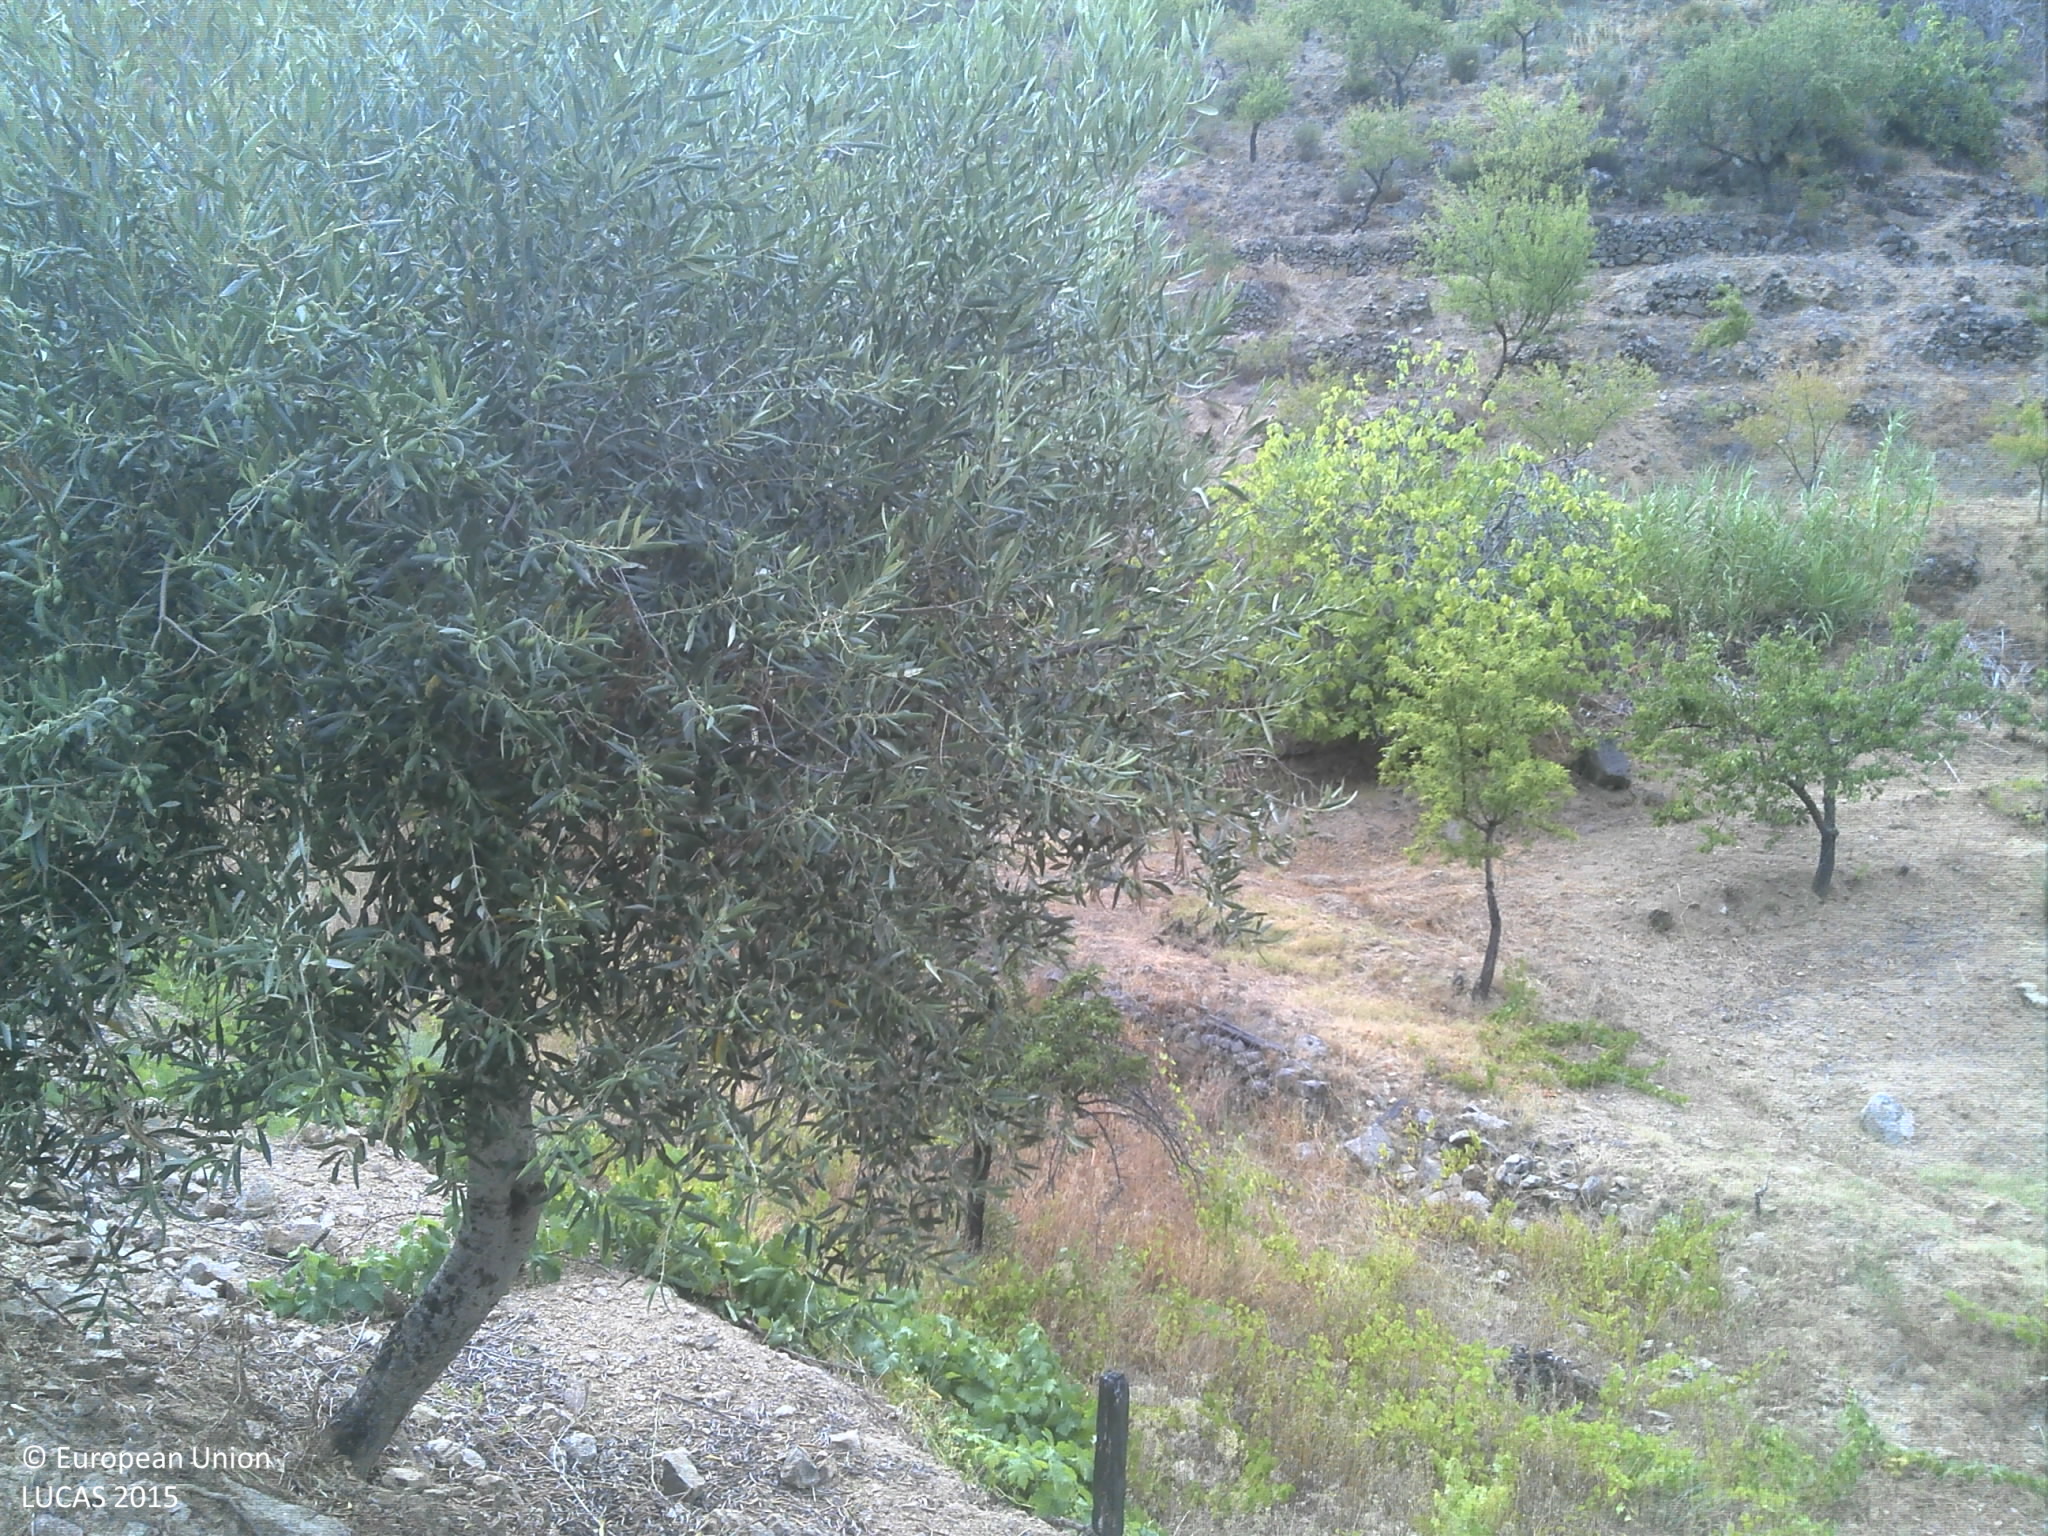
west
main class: Cropland
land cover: Olive groves
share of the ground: 10 - 25 %
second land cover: Other bare soil
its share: > 75 %
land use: Agriculture (excluding fallow land and kitchen gardens)
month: July
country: PT
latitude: 41.0705
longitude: -7.2396
